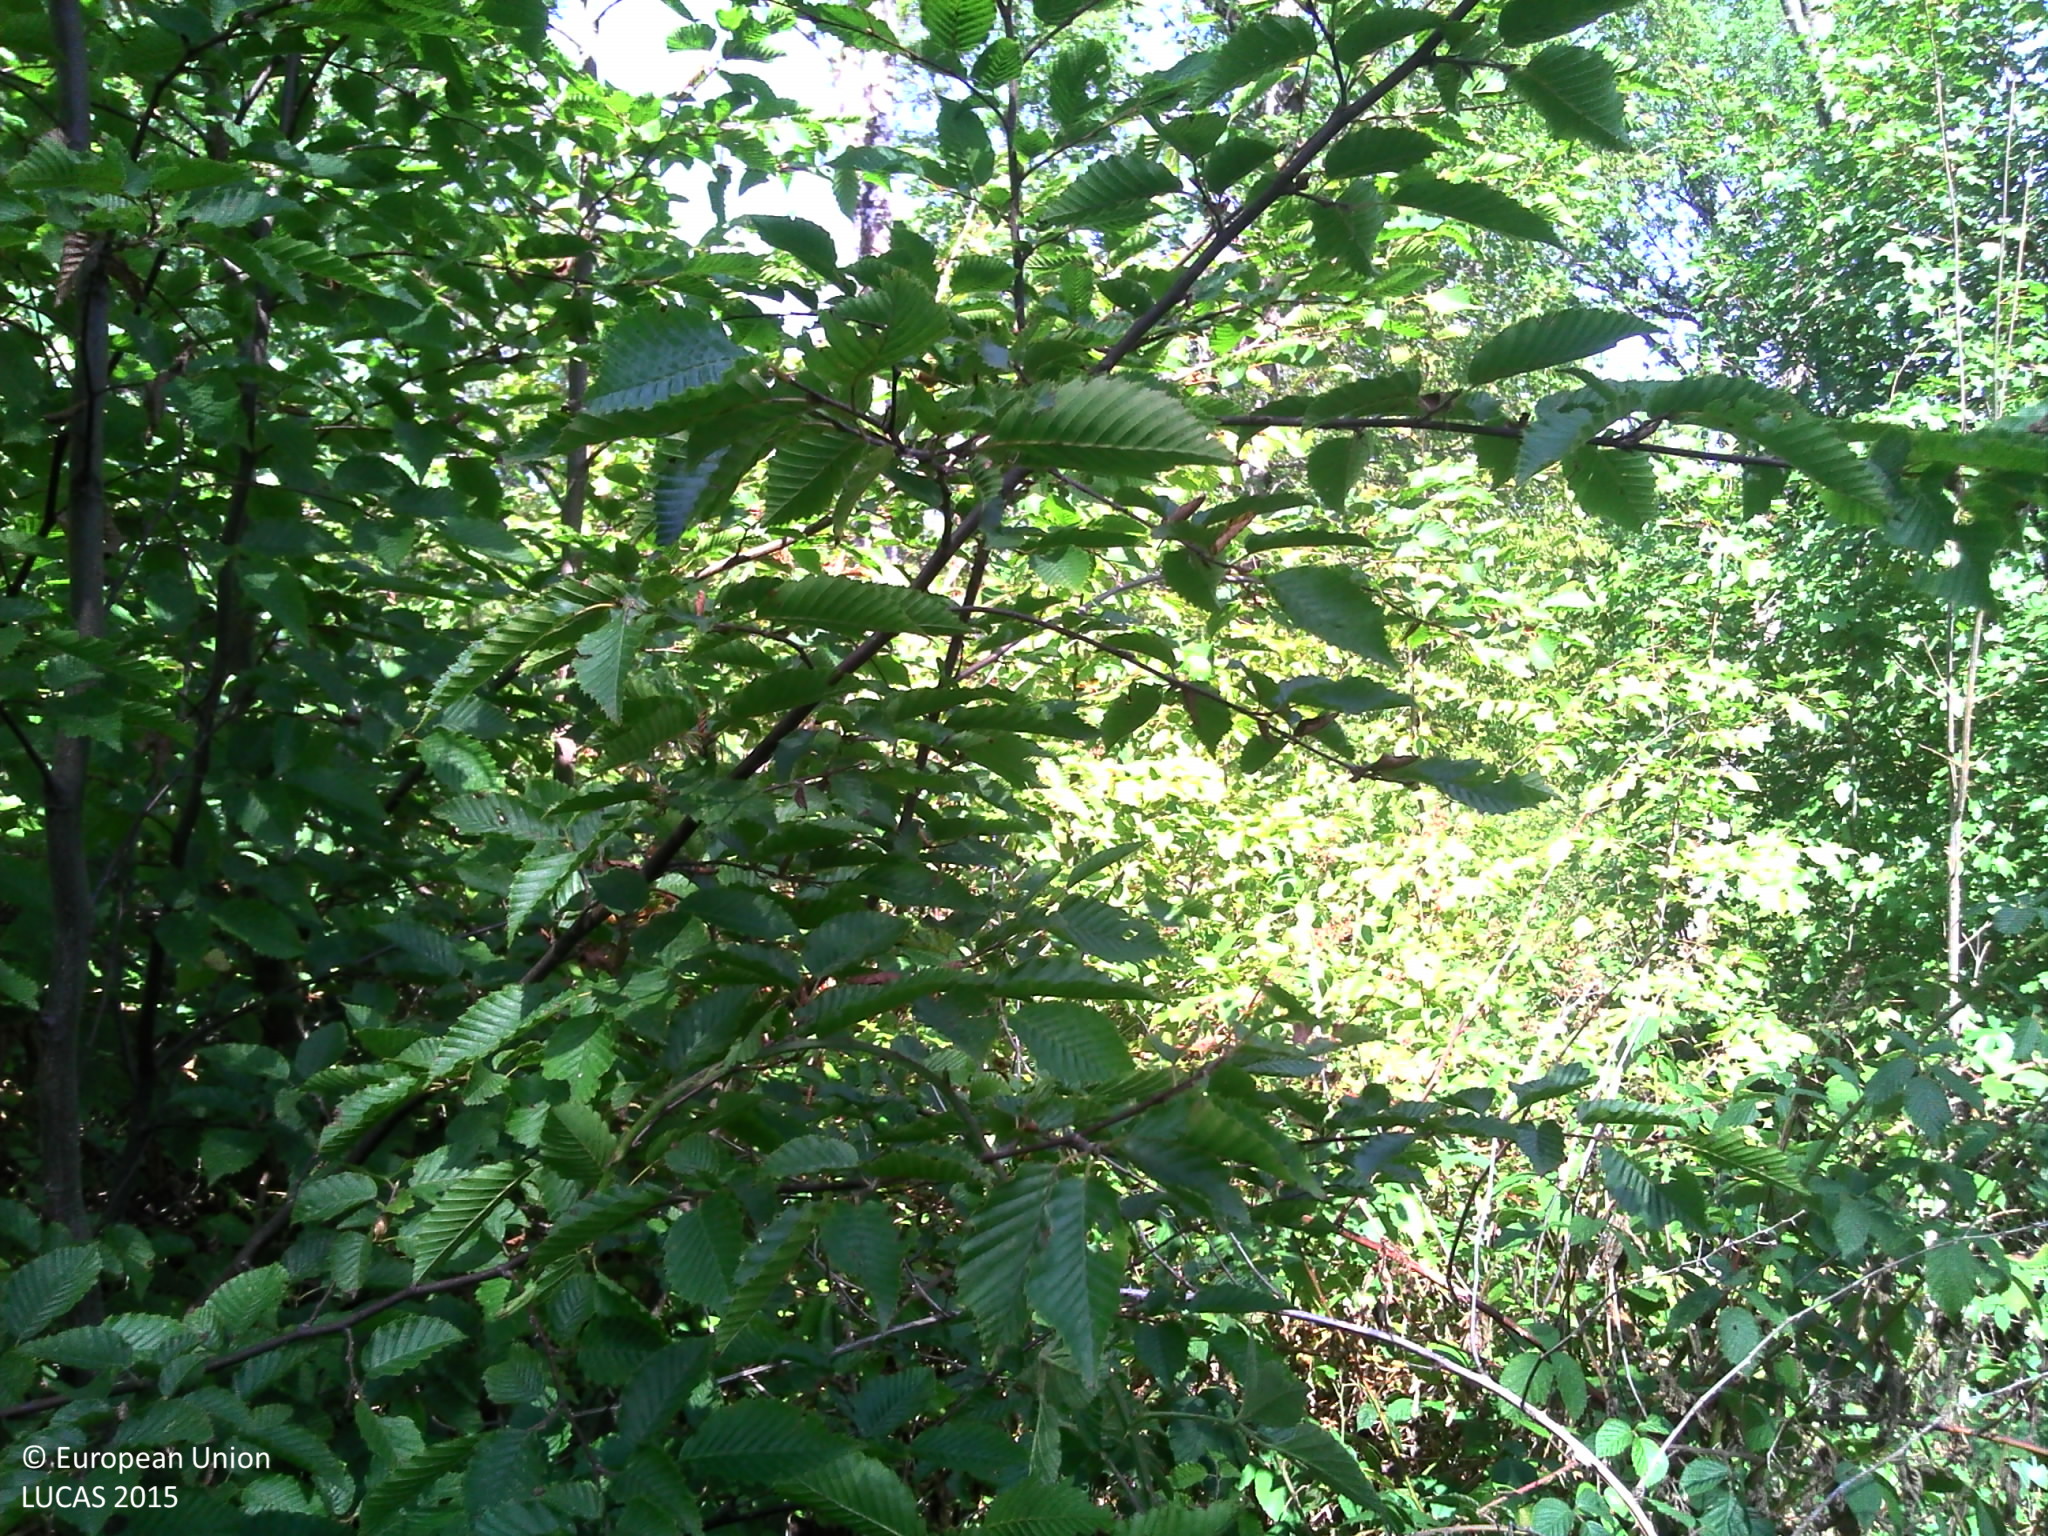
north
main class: Woodland
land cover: Broadleaved woodland
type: mesophytic deciduous forest
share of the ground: > 75 %
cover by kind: broadleaved forest trees 70 %, shrubs 20 %, herbaceous plants 10 %
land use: Forestry
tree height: > 5 m
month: August
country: FR
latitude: 47.2177
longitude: 4.8108
